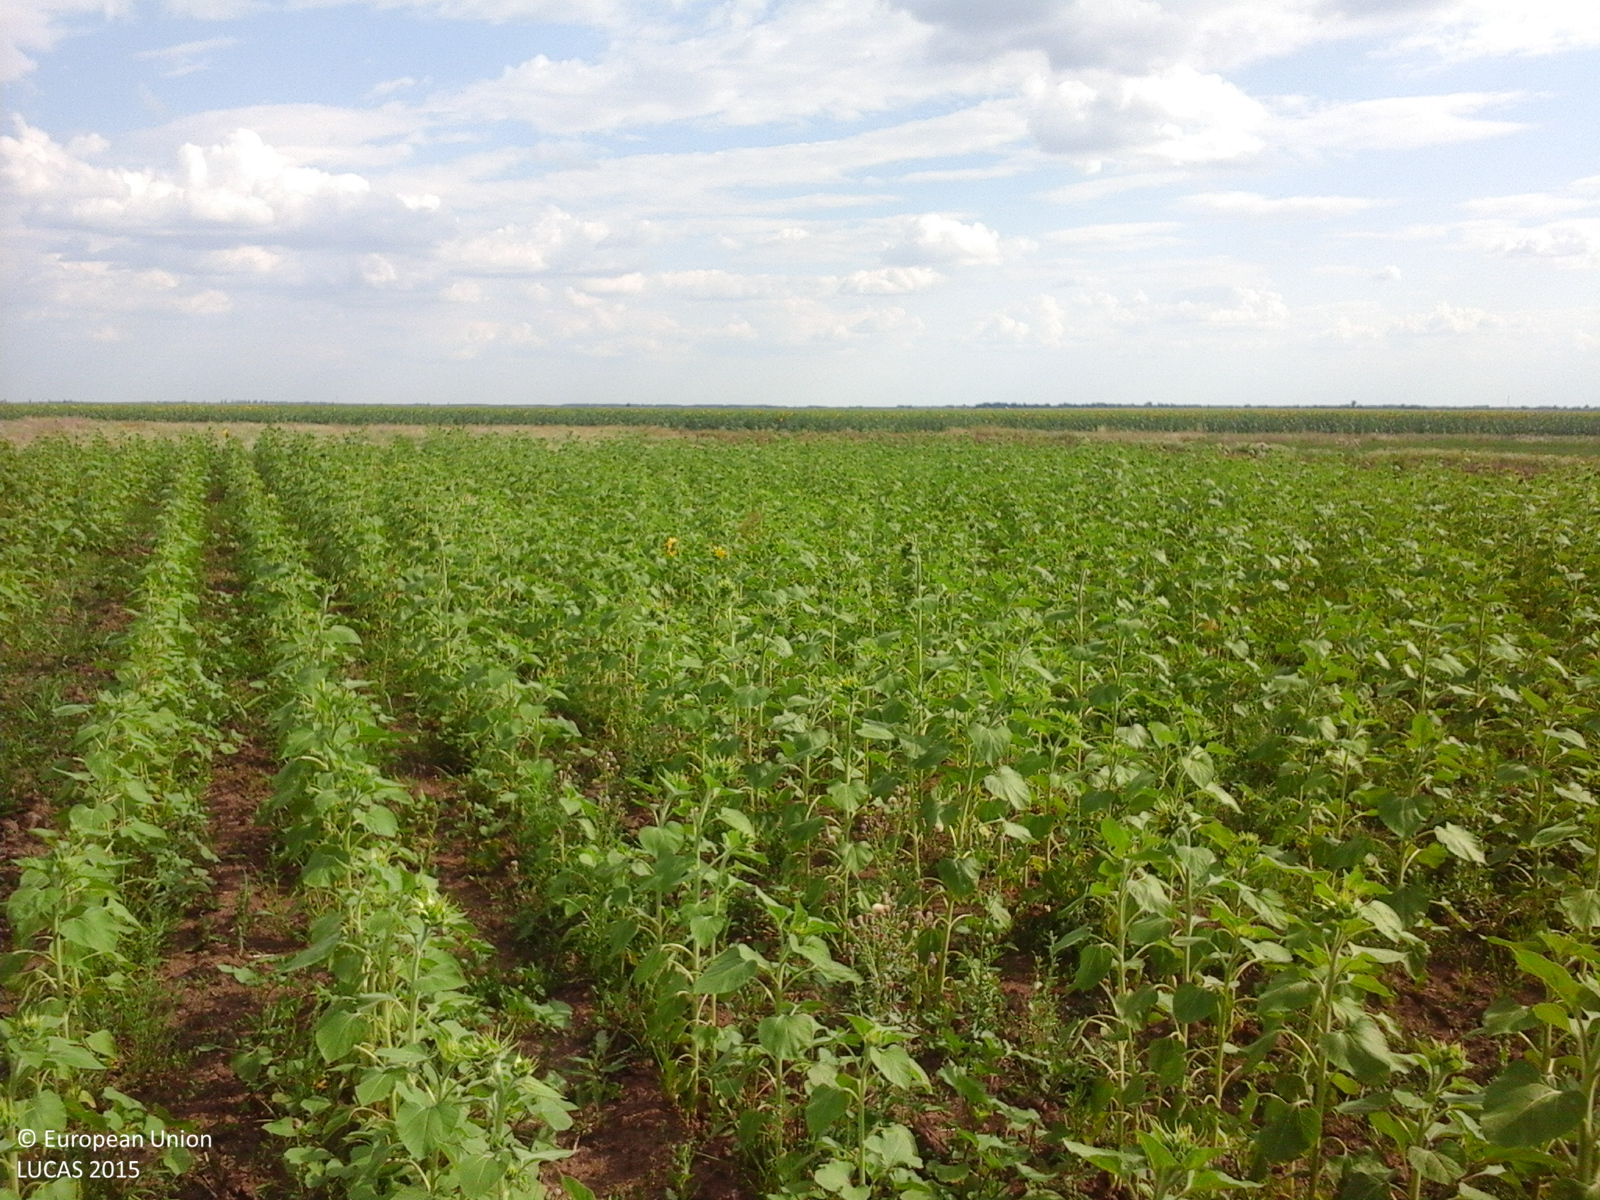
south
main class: Cropland
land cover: Sunflower
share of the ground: > 75 %
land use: Agriculture (excluding fallow land and kitchen gardens)
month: July
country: RO
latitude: 44.2252
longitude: 25.1153
